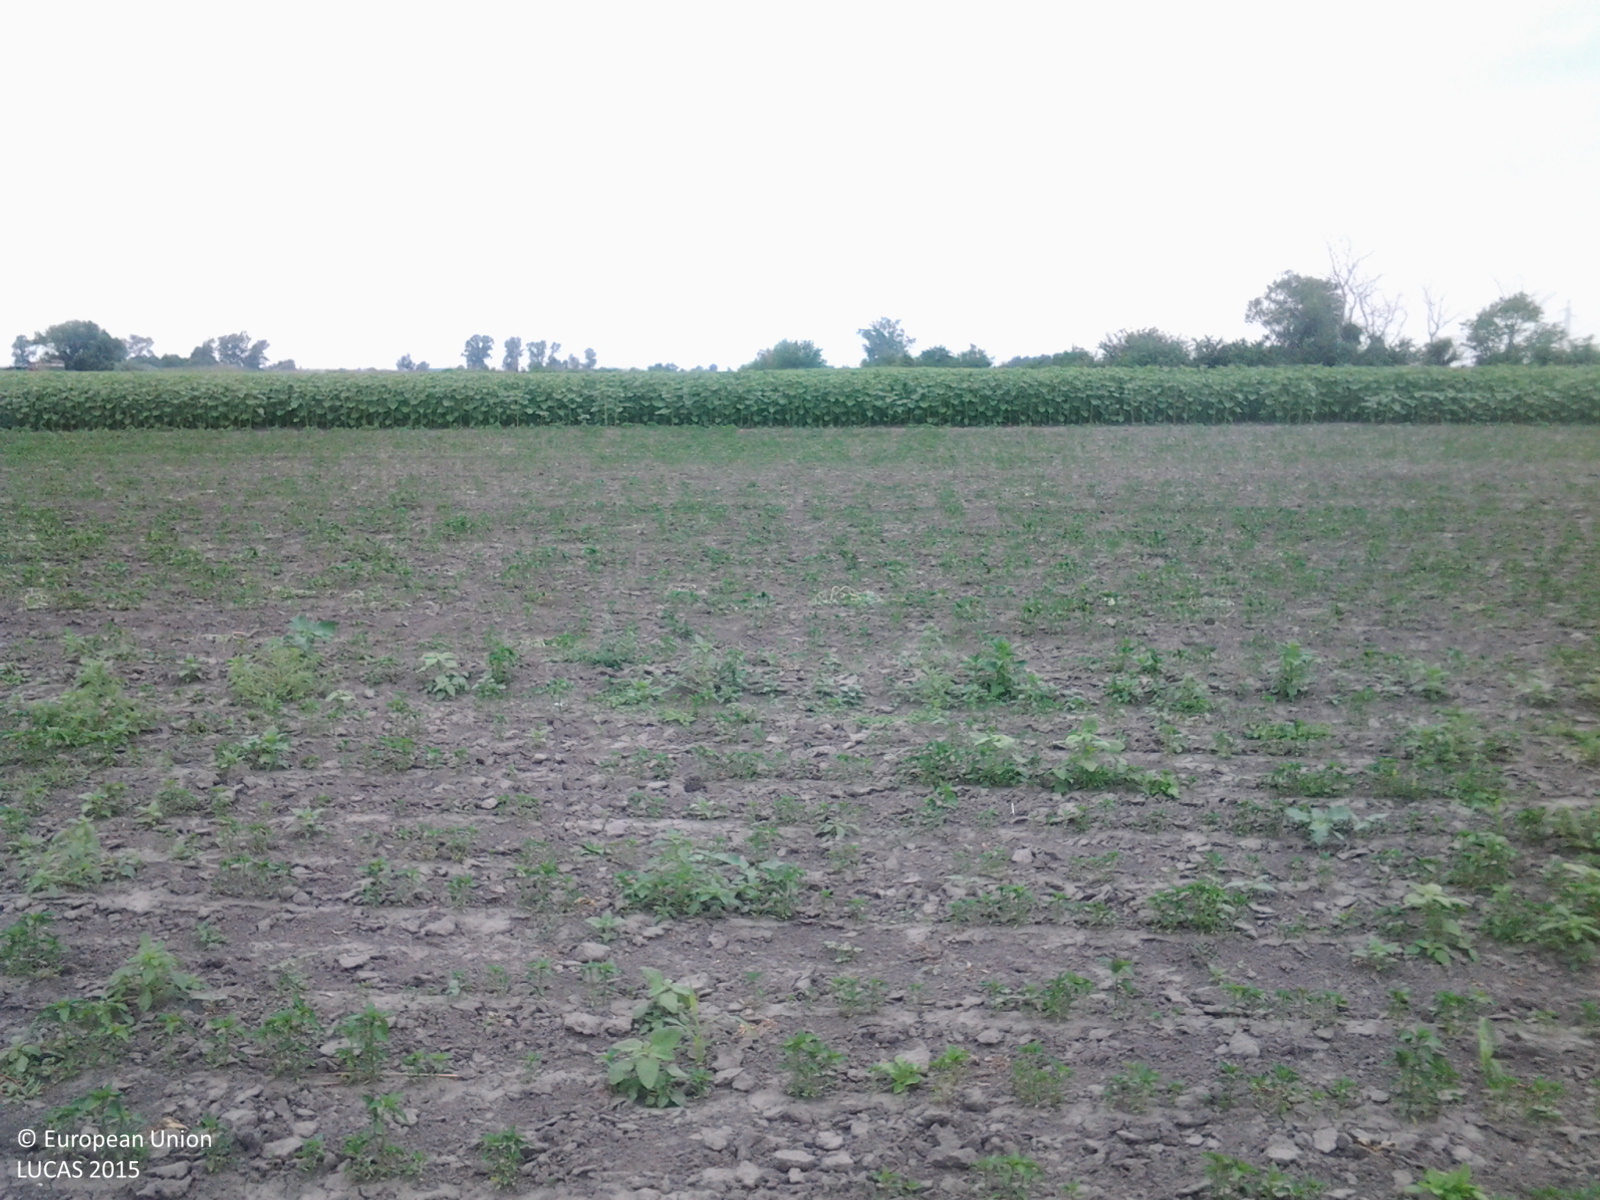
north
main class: Cropland
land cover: Other fresh vegetables
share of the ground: 25 - 50 %
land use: Agriculture (excluding fallow land and kitchen gardens)
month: June
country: HU
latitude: 46.3501
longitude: 19.0184
